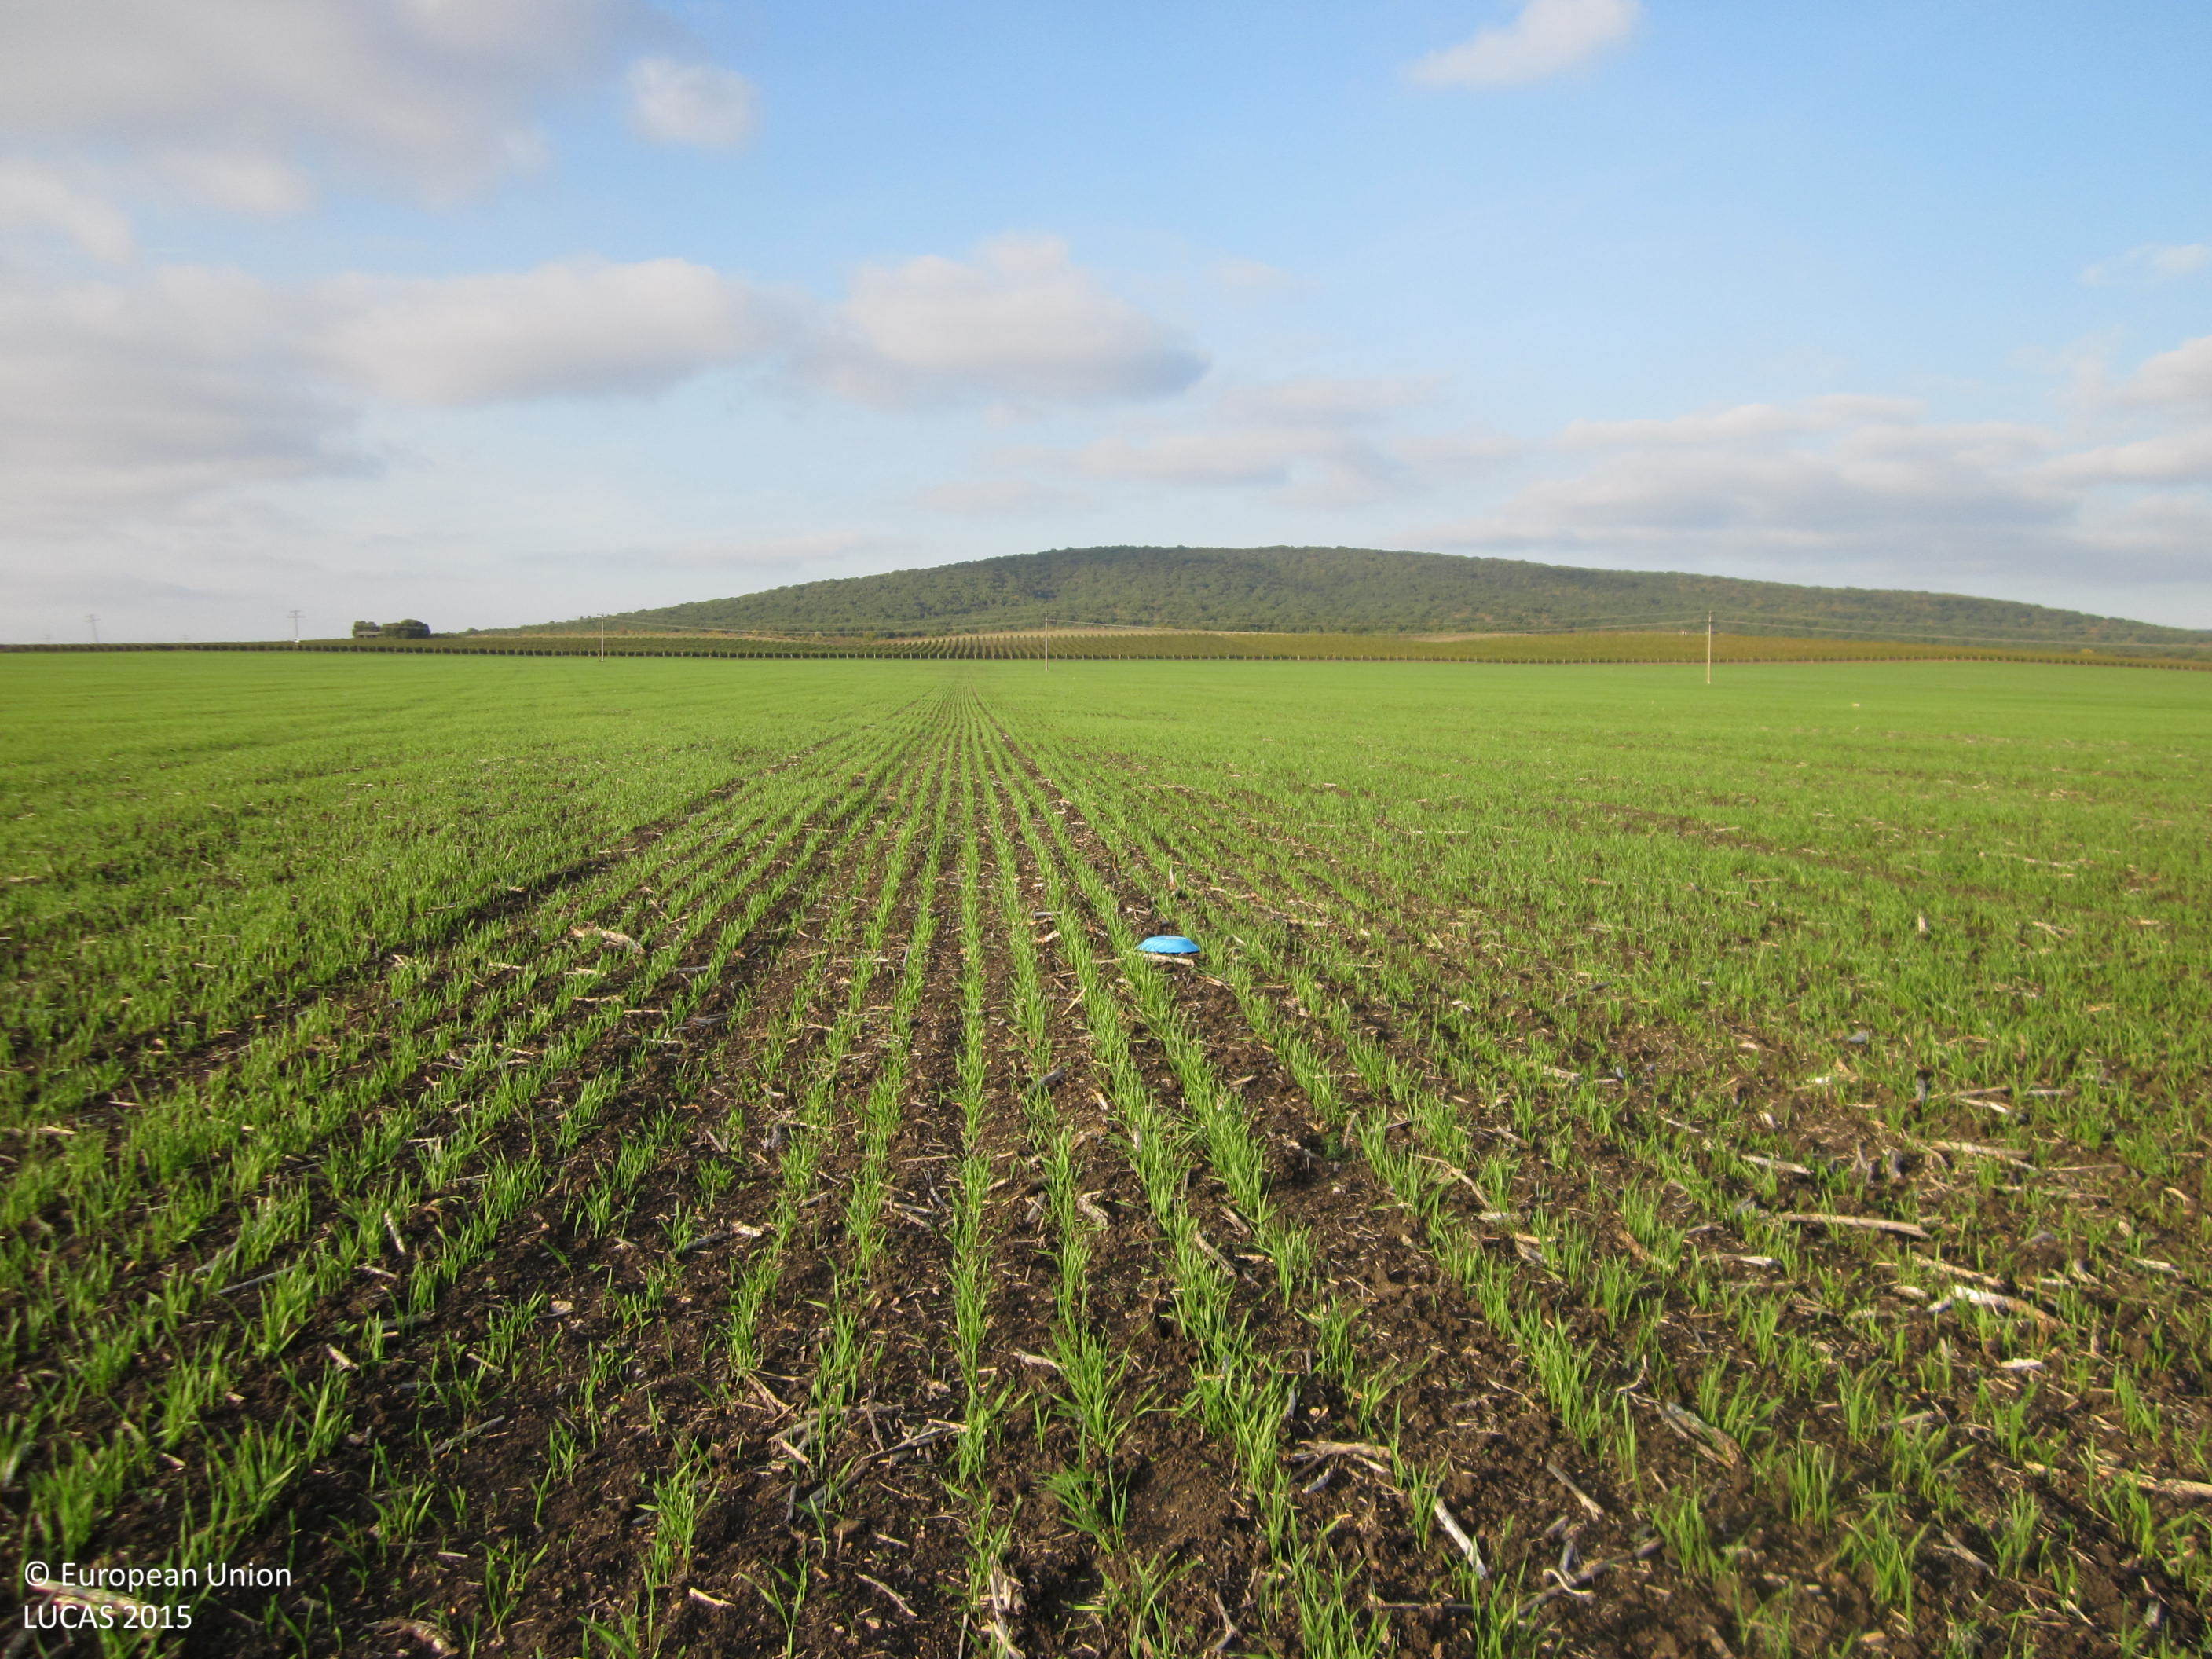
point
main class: Cropland
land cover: Common wheat
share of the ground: 25 - 50 %
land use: Agriculture (excluding fallow land and kitchen gardens)
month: October
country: BG
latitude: 42.7274
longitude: 26.9228
